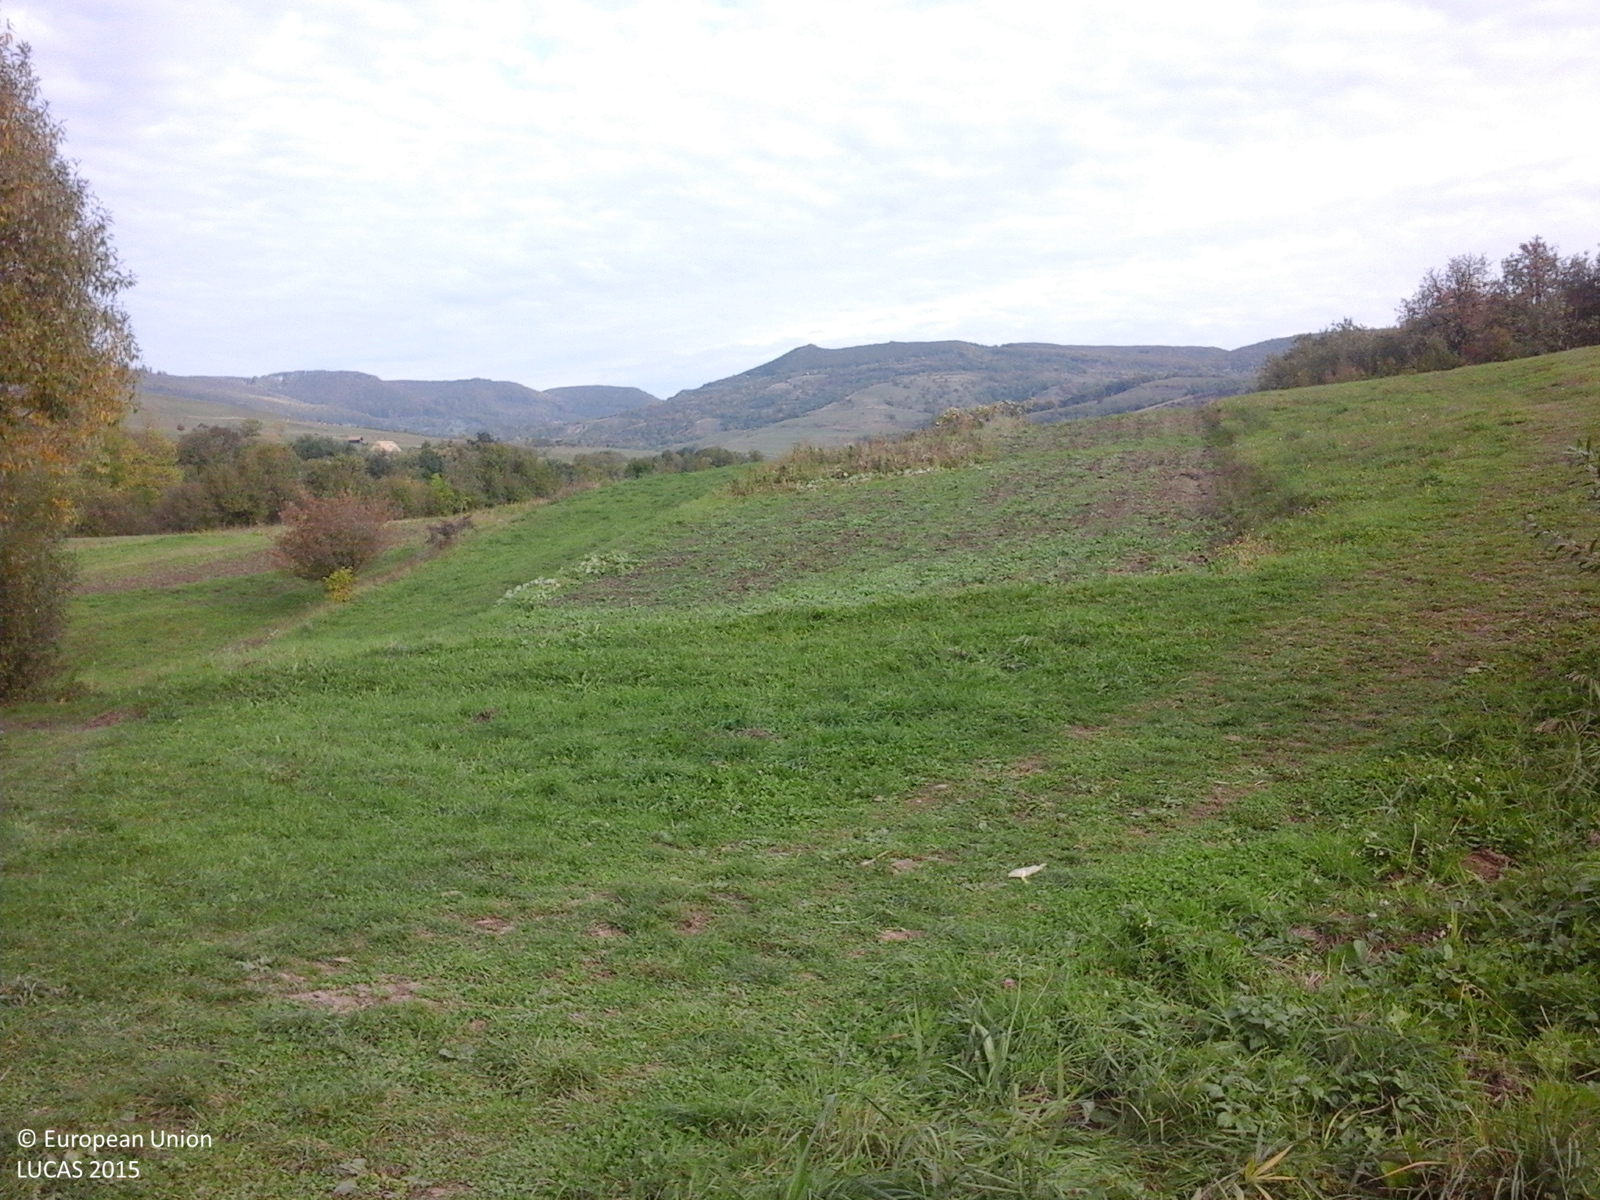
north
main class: Grassland
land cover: Grassland without tree/shrub cover
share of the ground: > 75 %
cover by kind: herbaceous plants 100 %
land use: Agriculture (excluding fallow land and kitchen gardens)
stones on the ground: < 10 %
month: October
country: RO
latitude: 46.3741
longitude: 25.3272
